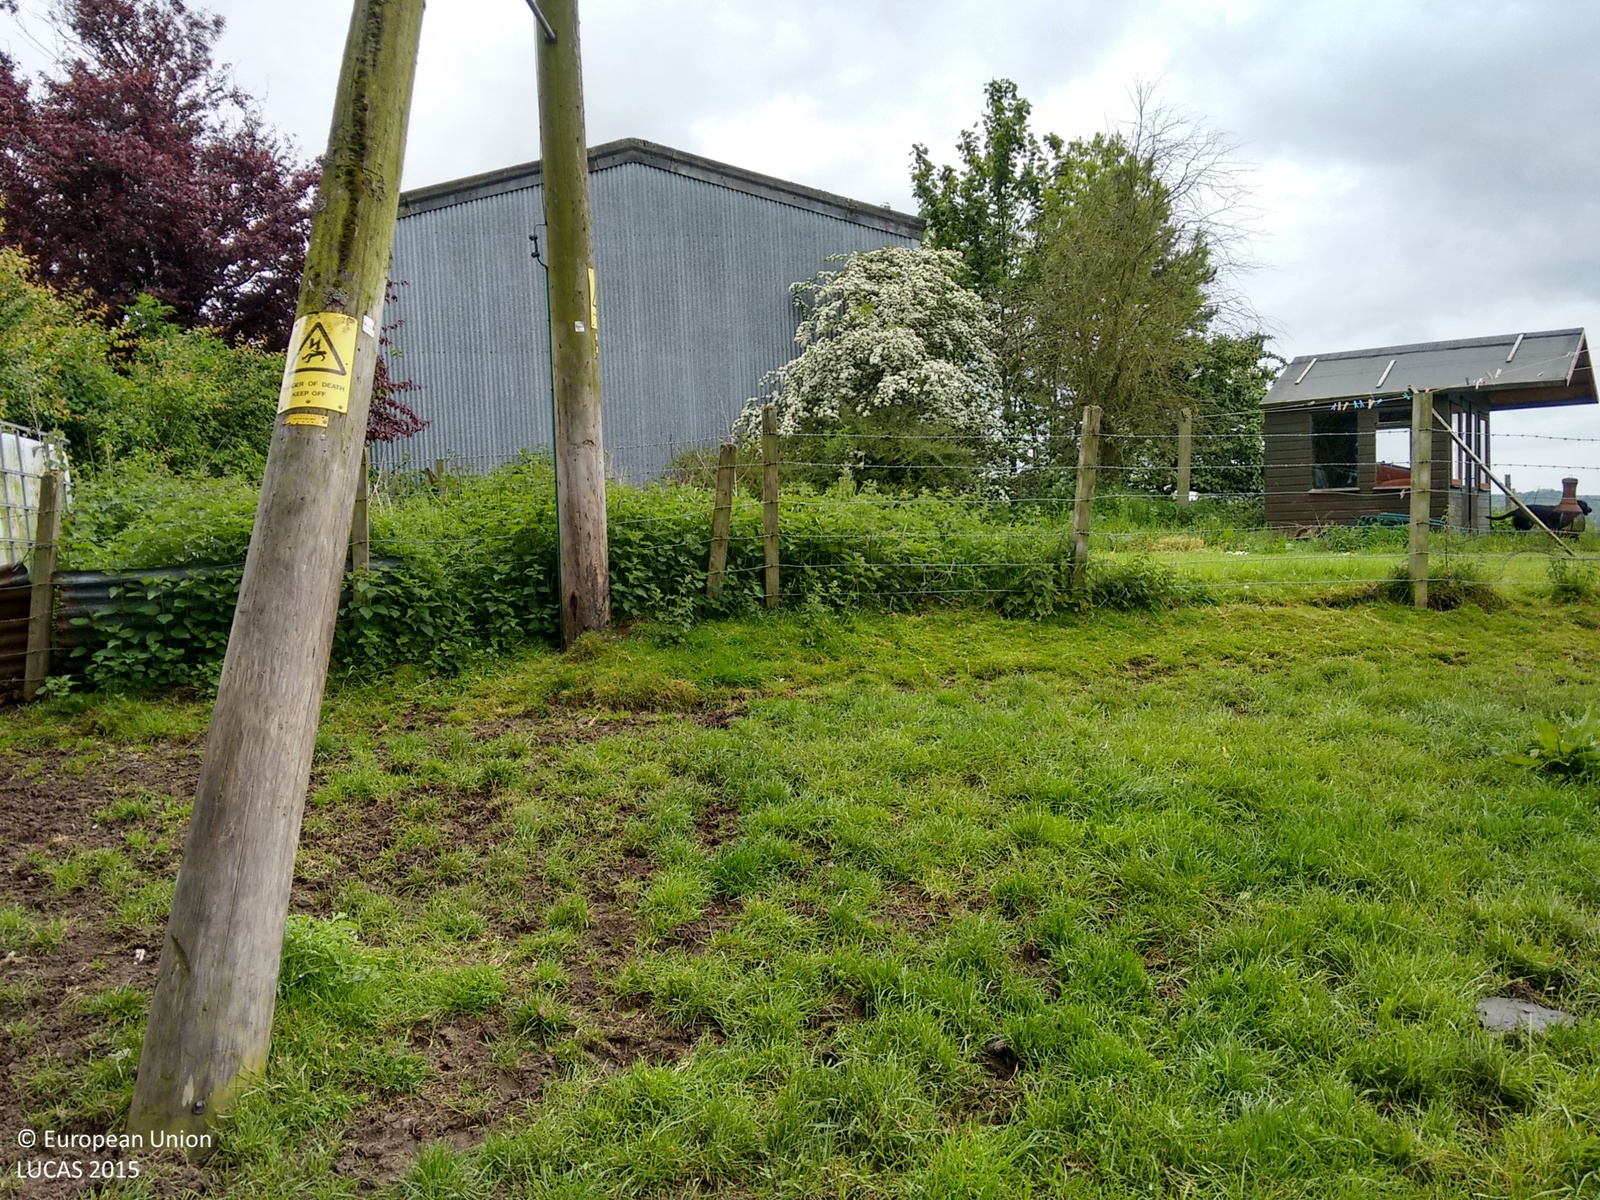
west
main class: Grassland
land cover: Grassland without tree/shrub cover
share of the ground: > 75 %
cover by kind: herbaceous plants 90 %, unconsolidated bare surface 10 %
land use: Agriculture (excluding fallow land and kitchen gardens)
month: June
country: GB
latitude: 56.3753
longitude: -3.3999
